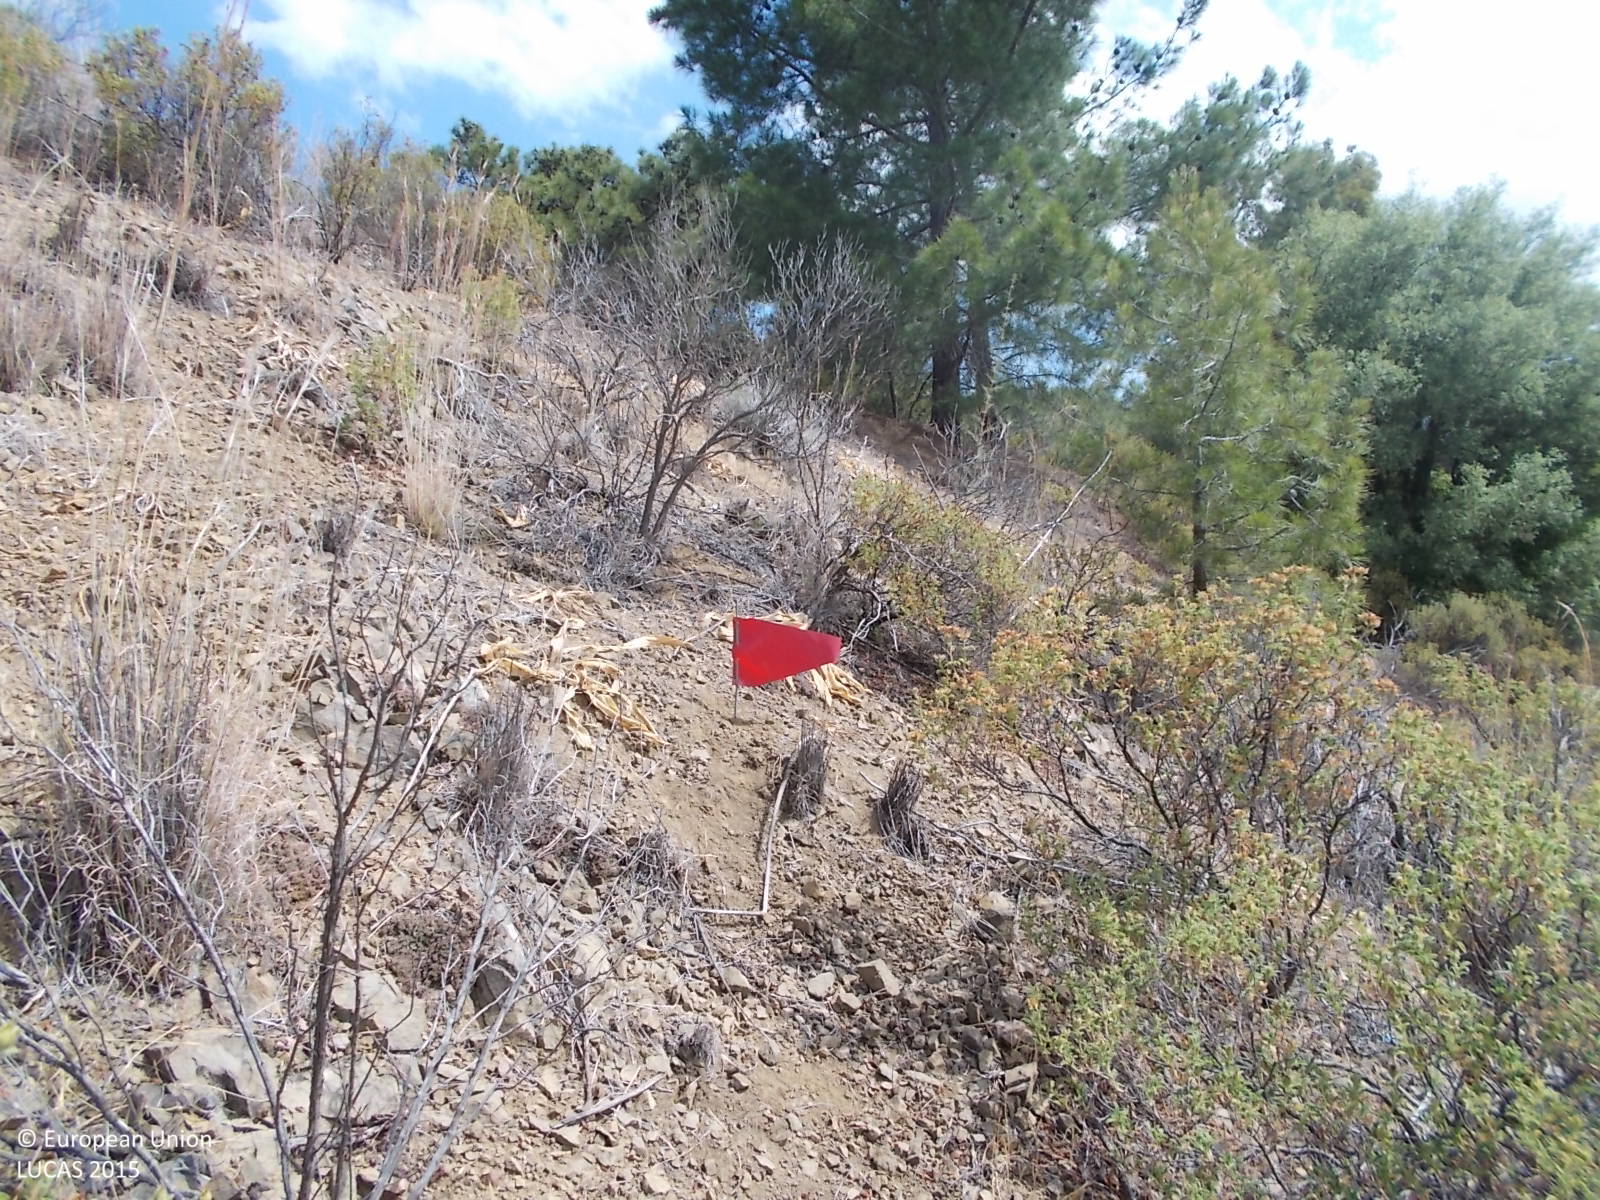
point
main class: Woodland
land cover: Pine dominated coniferous woodland
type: coniferous forest of the mediterranean region
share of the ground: 25 - 50 %
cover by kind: shrubs 35 %, unconsolidated bare surface 35 %, coniferous forest trees 30 %
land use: Forestry
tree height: > 5 m
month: June
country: CY
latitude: 34.9052
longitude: 32.7839
